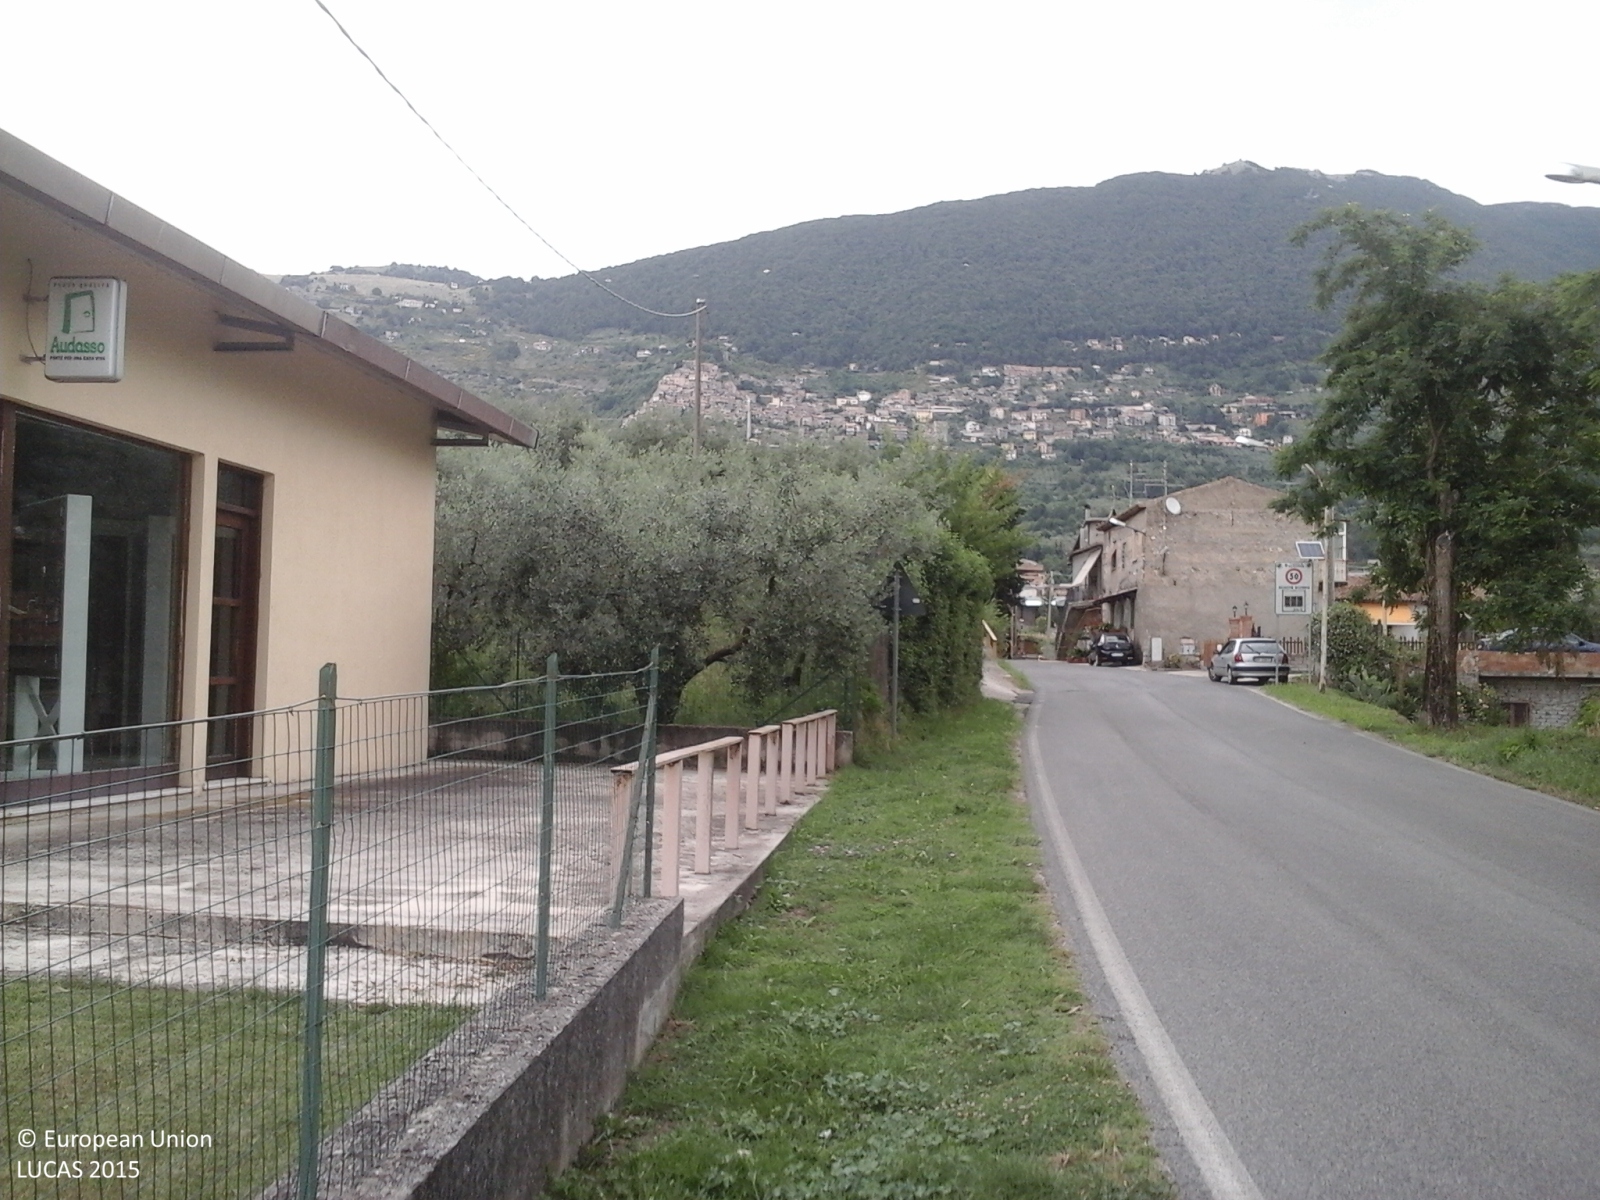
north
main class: Grassland
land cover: Grassland without tree/shrub cover
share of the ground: > 75 %
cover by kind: herbaceous plants 100 %
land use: Residential
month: June
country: IT
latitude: 41.8297
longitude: 13.0831
